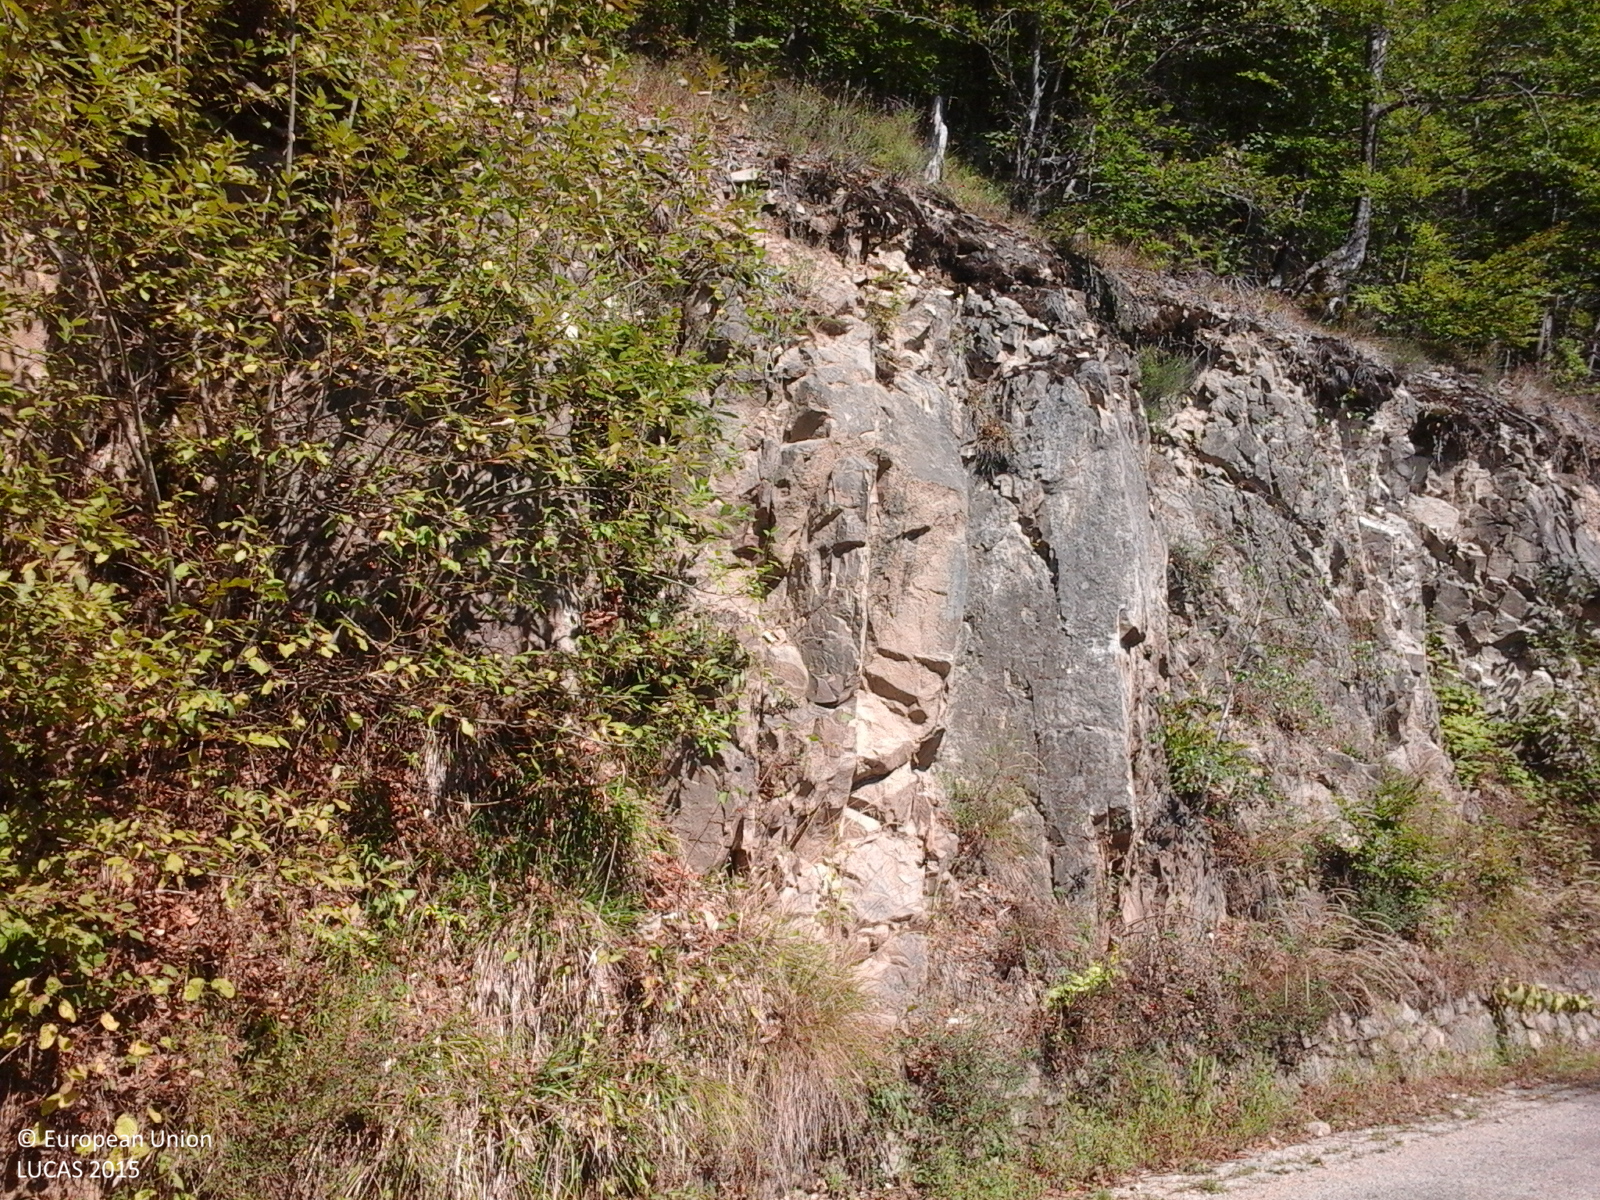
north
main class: Woodland
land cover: Broadleaved woodland
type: beech forest
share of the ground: > 75 %
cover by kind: broadleaved forest trees 100 %
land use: Forestry
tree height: > 5 m
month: September
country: RO
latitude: 46.6817
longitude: 22.5651
